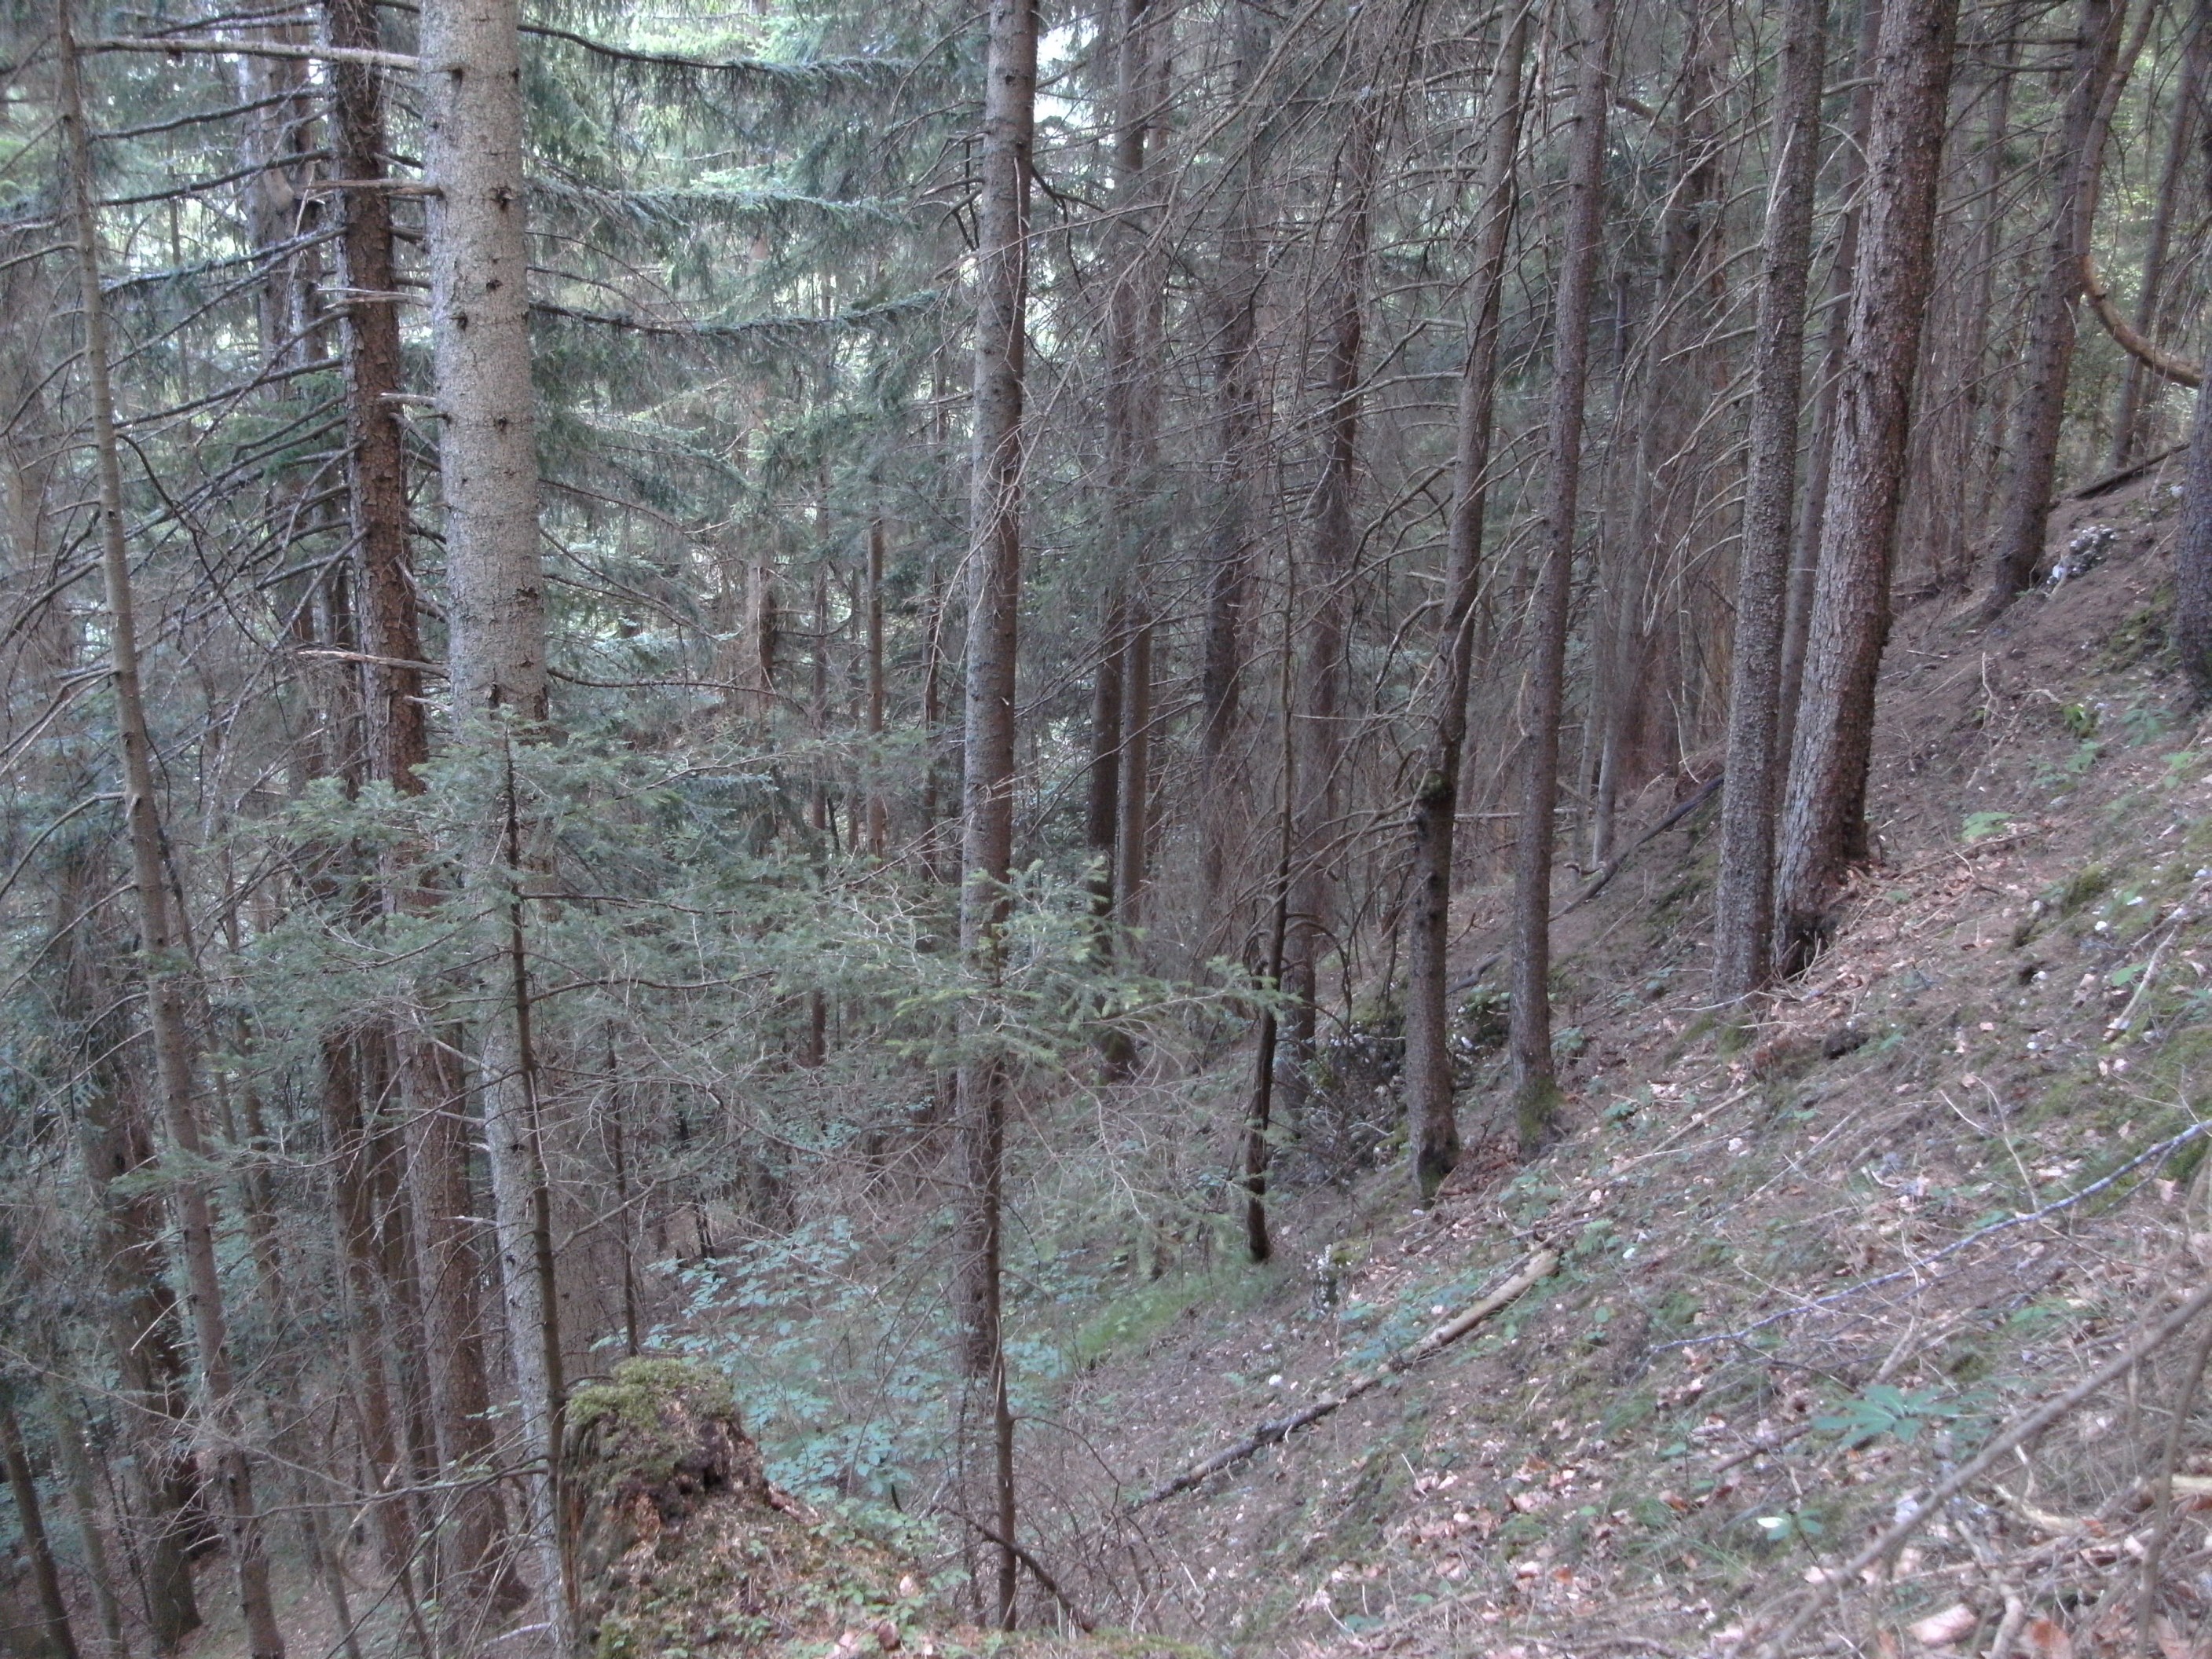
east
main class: Woodland
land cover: Spruce dominated coniferous woodland
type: hemiboreal forest and nemoral coniferous forest and mixed broadleaved-coniferous forest
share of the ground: > 75 %
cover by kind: coniferous forest trees 65 %, broadleaved forest trees 20 %, unconsolidated bare surface 10 %, lichens and mosses 5 %
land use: Forestry
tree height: > 5 m
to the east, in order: Spruce dominated coniferous woodland; Spruce dominated mixed woodland; Tracks; Spruce dominated coniferous woodland; Rivers and streams; Spruce dominated coniferous woodland; Spruce dominated mixed woodland; Tracks; Spruce dominated mixed woodland; Spruce dominated coniferous woodland
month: July
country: AT
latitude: 46.5375
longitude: 14.6787
